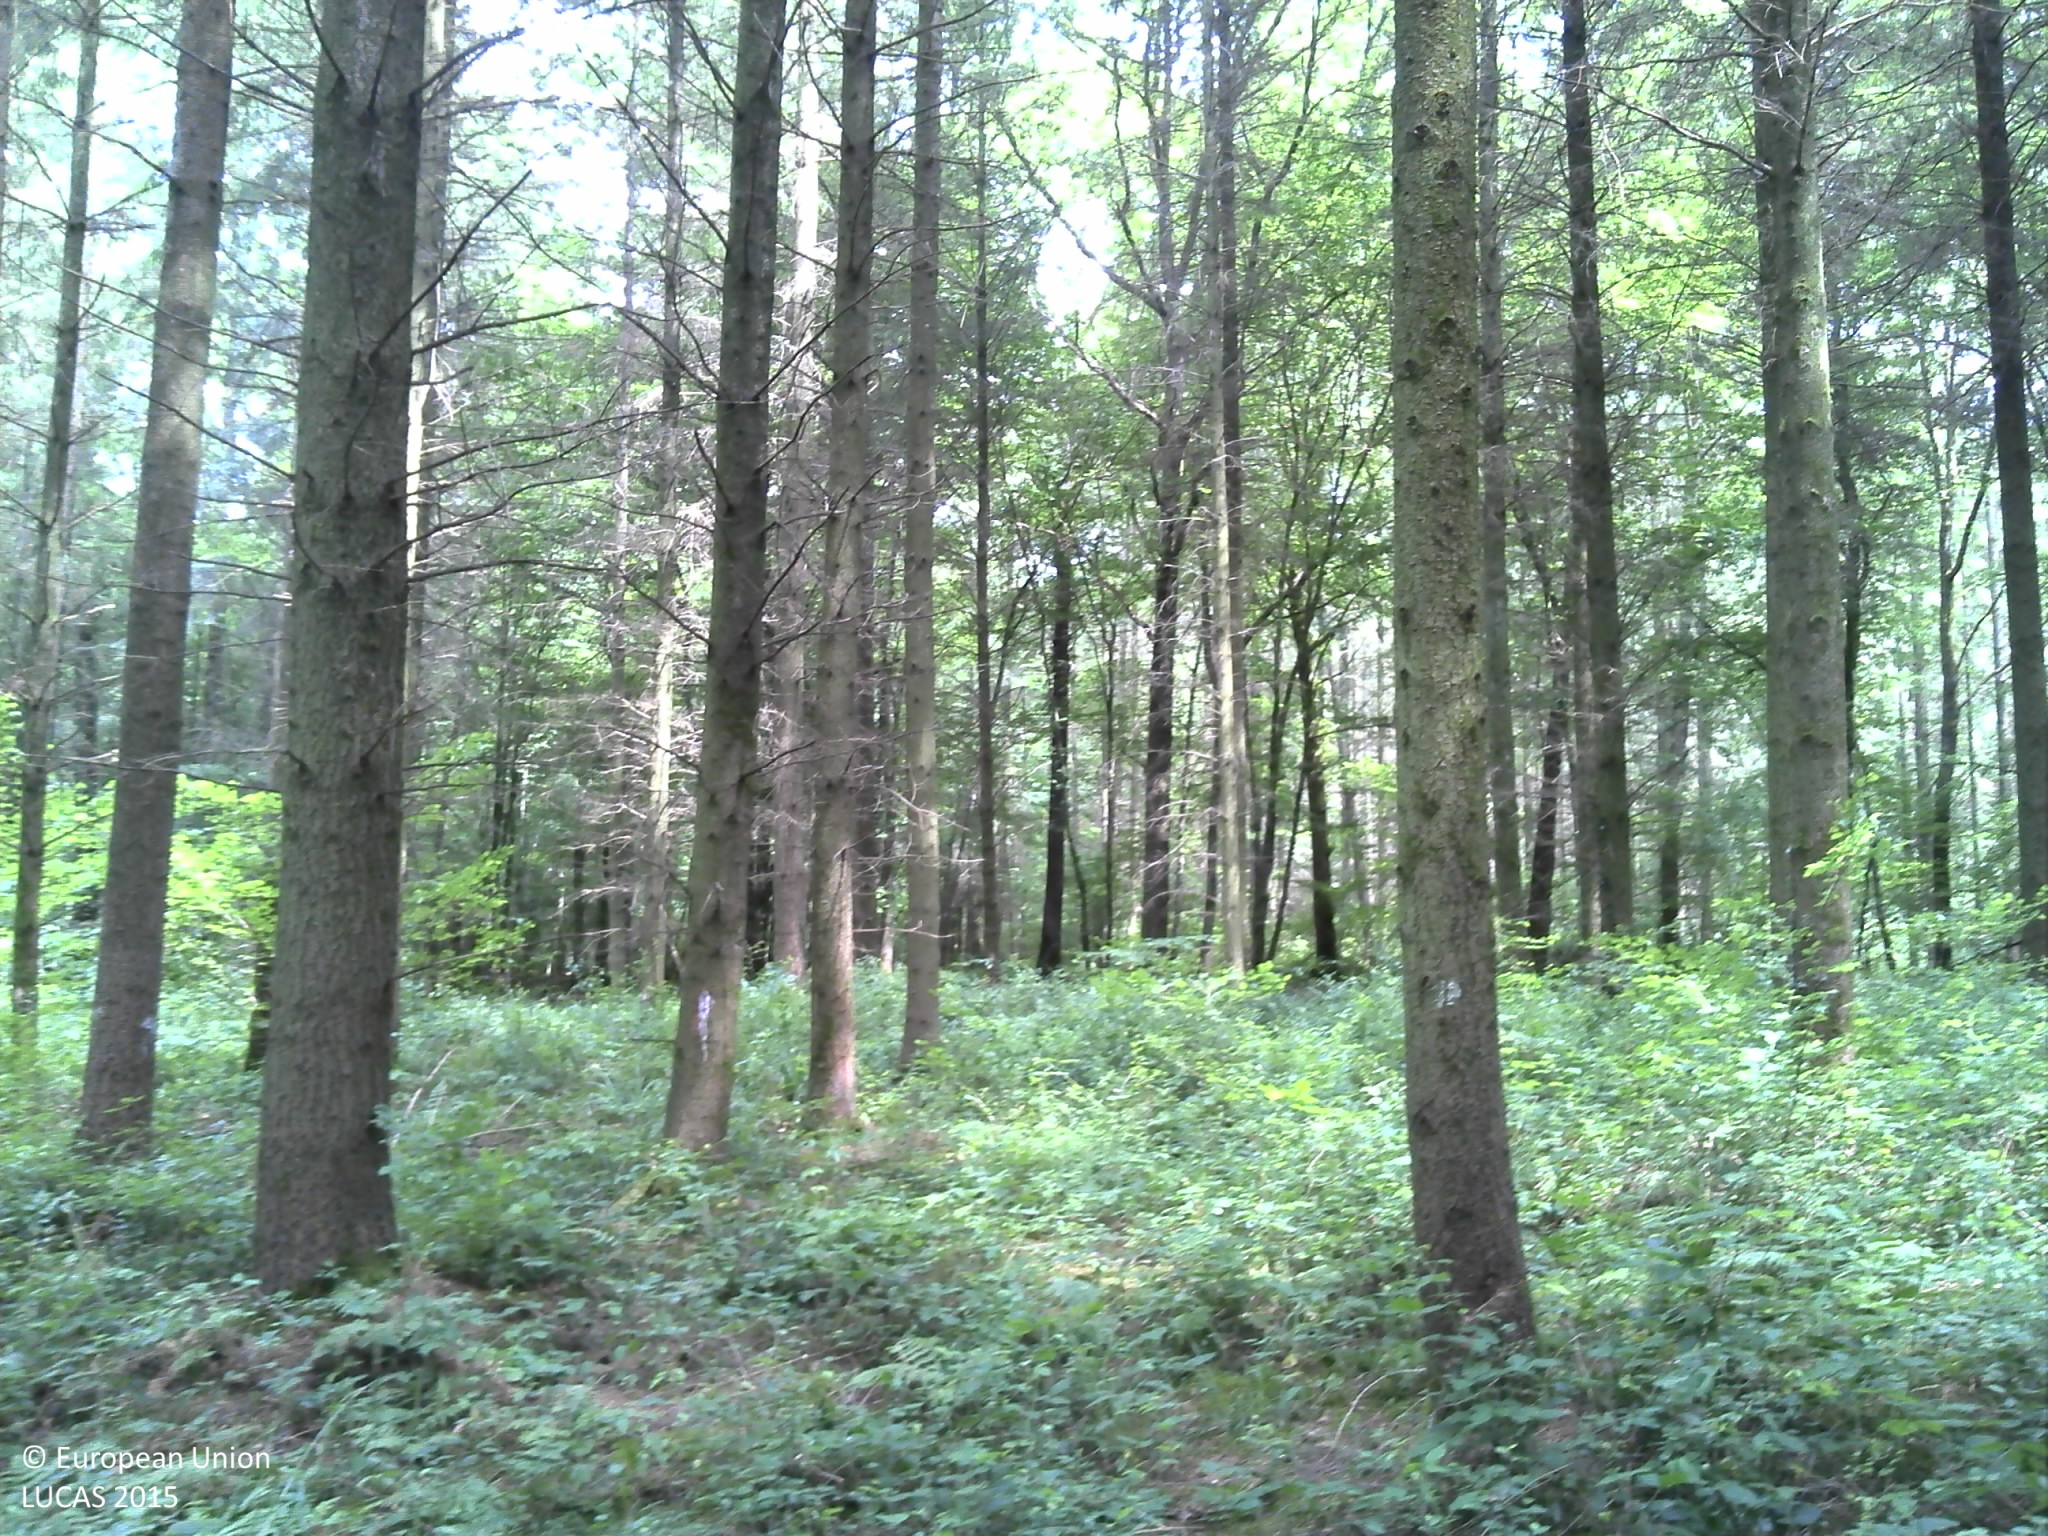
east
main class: Woodland
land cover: Spruce dominated coniferous woodland
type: exotic forest
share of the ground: 50 - 75 %
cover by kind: coniferous forest trees 60 %, herbaceous plants 20 %, broadleaved forest trees 10 %, lichens and mosses 10 %
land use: Forestry
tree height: > 5 m
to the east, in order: Spruce dominated coniferous woodland; Broadleaved woodland
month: June
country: FR
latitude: 49.3643
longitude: 4.8335
